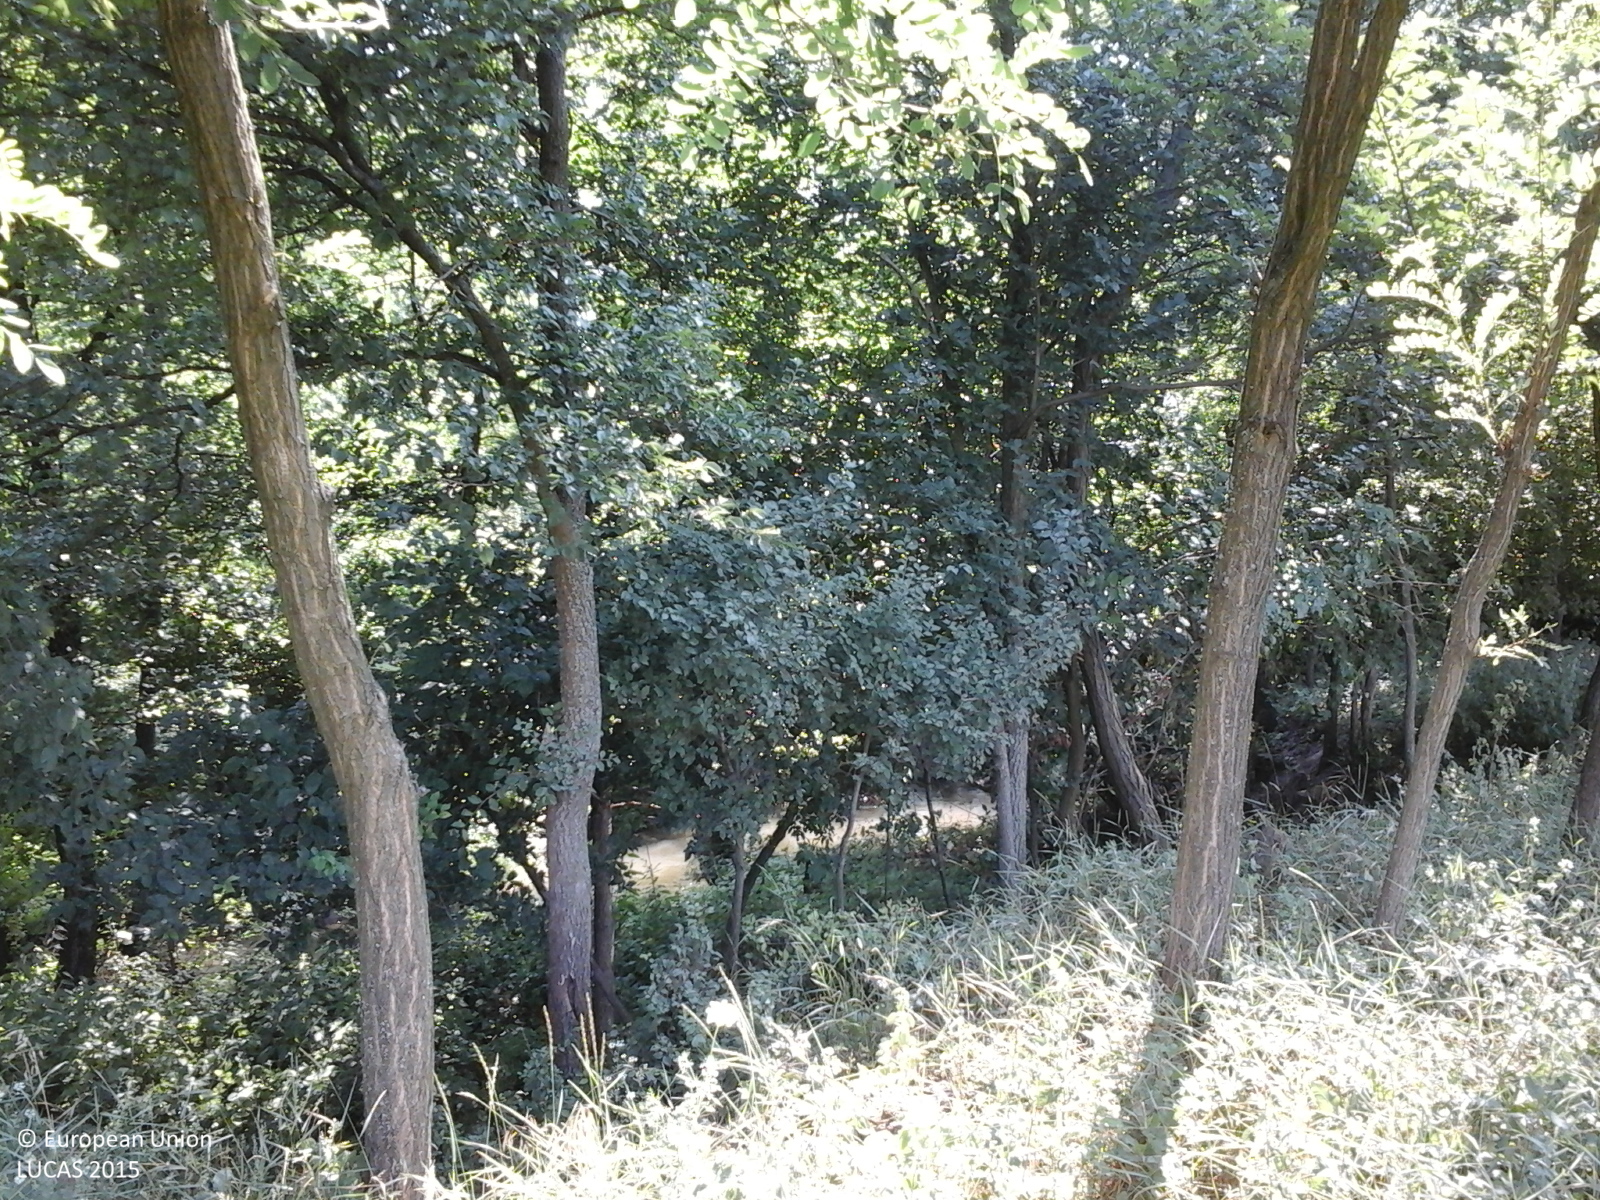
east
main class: Grassland
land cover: Grassland without tree/shrub cover
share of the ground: > 75 %
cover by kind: herbaceous plants 100 %
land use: Agriculture (excluding fallow land and kitchen gardens)
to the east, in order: Grassland without tree/shrub cover; Broadleaved woodland; Inland fresh running water; Broadleaved woodland; Permanent crops (only in case pi); Lines of trees; Artificial constructions in urban areas; Grassland without tree/shrub cover
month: July
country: RO
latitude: 44.7155
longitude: 25.6365
